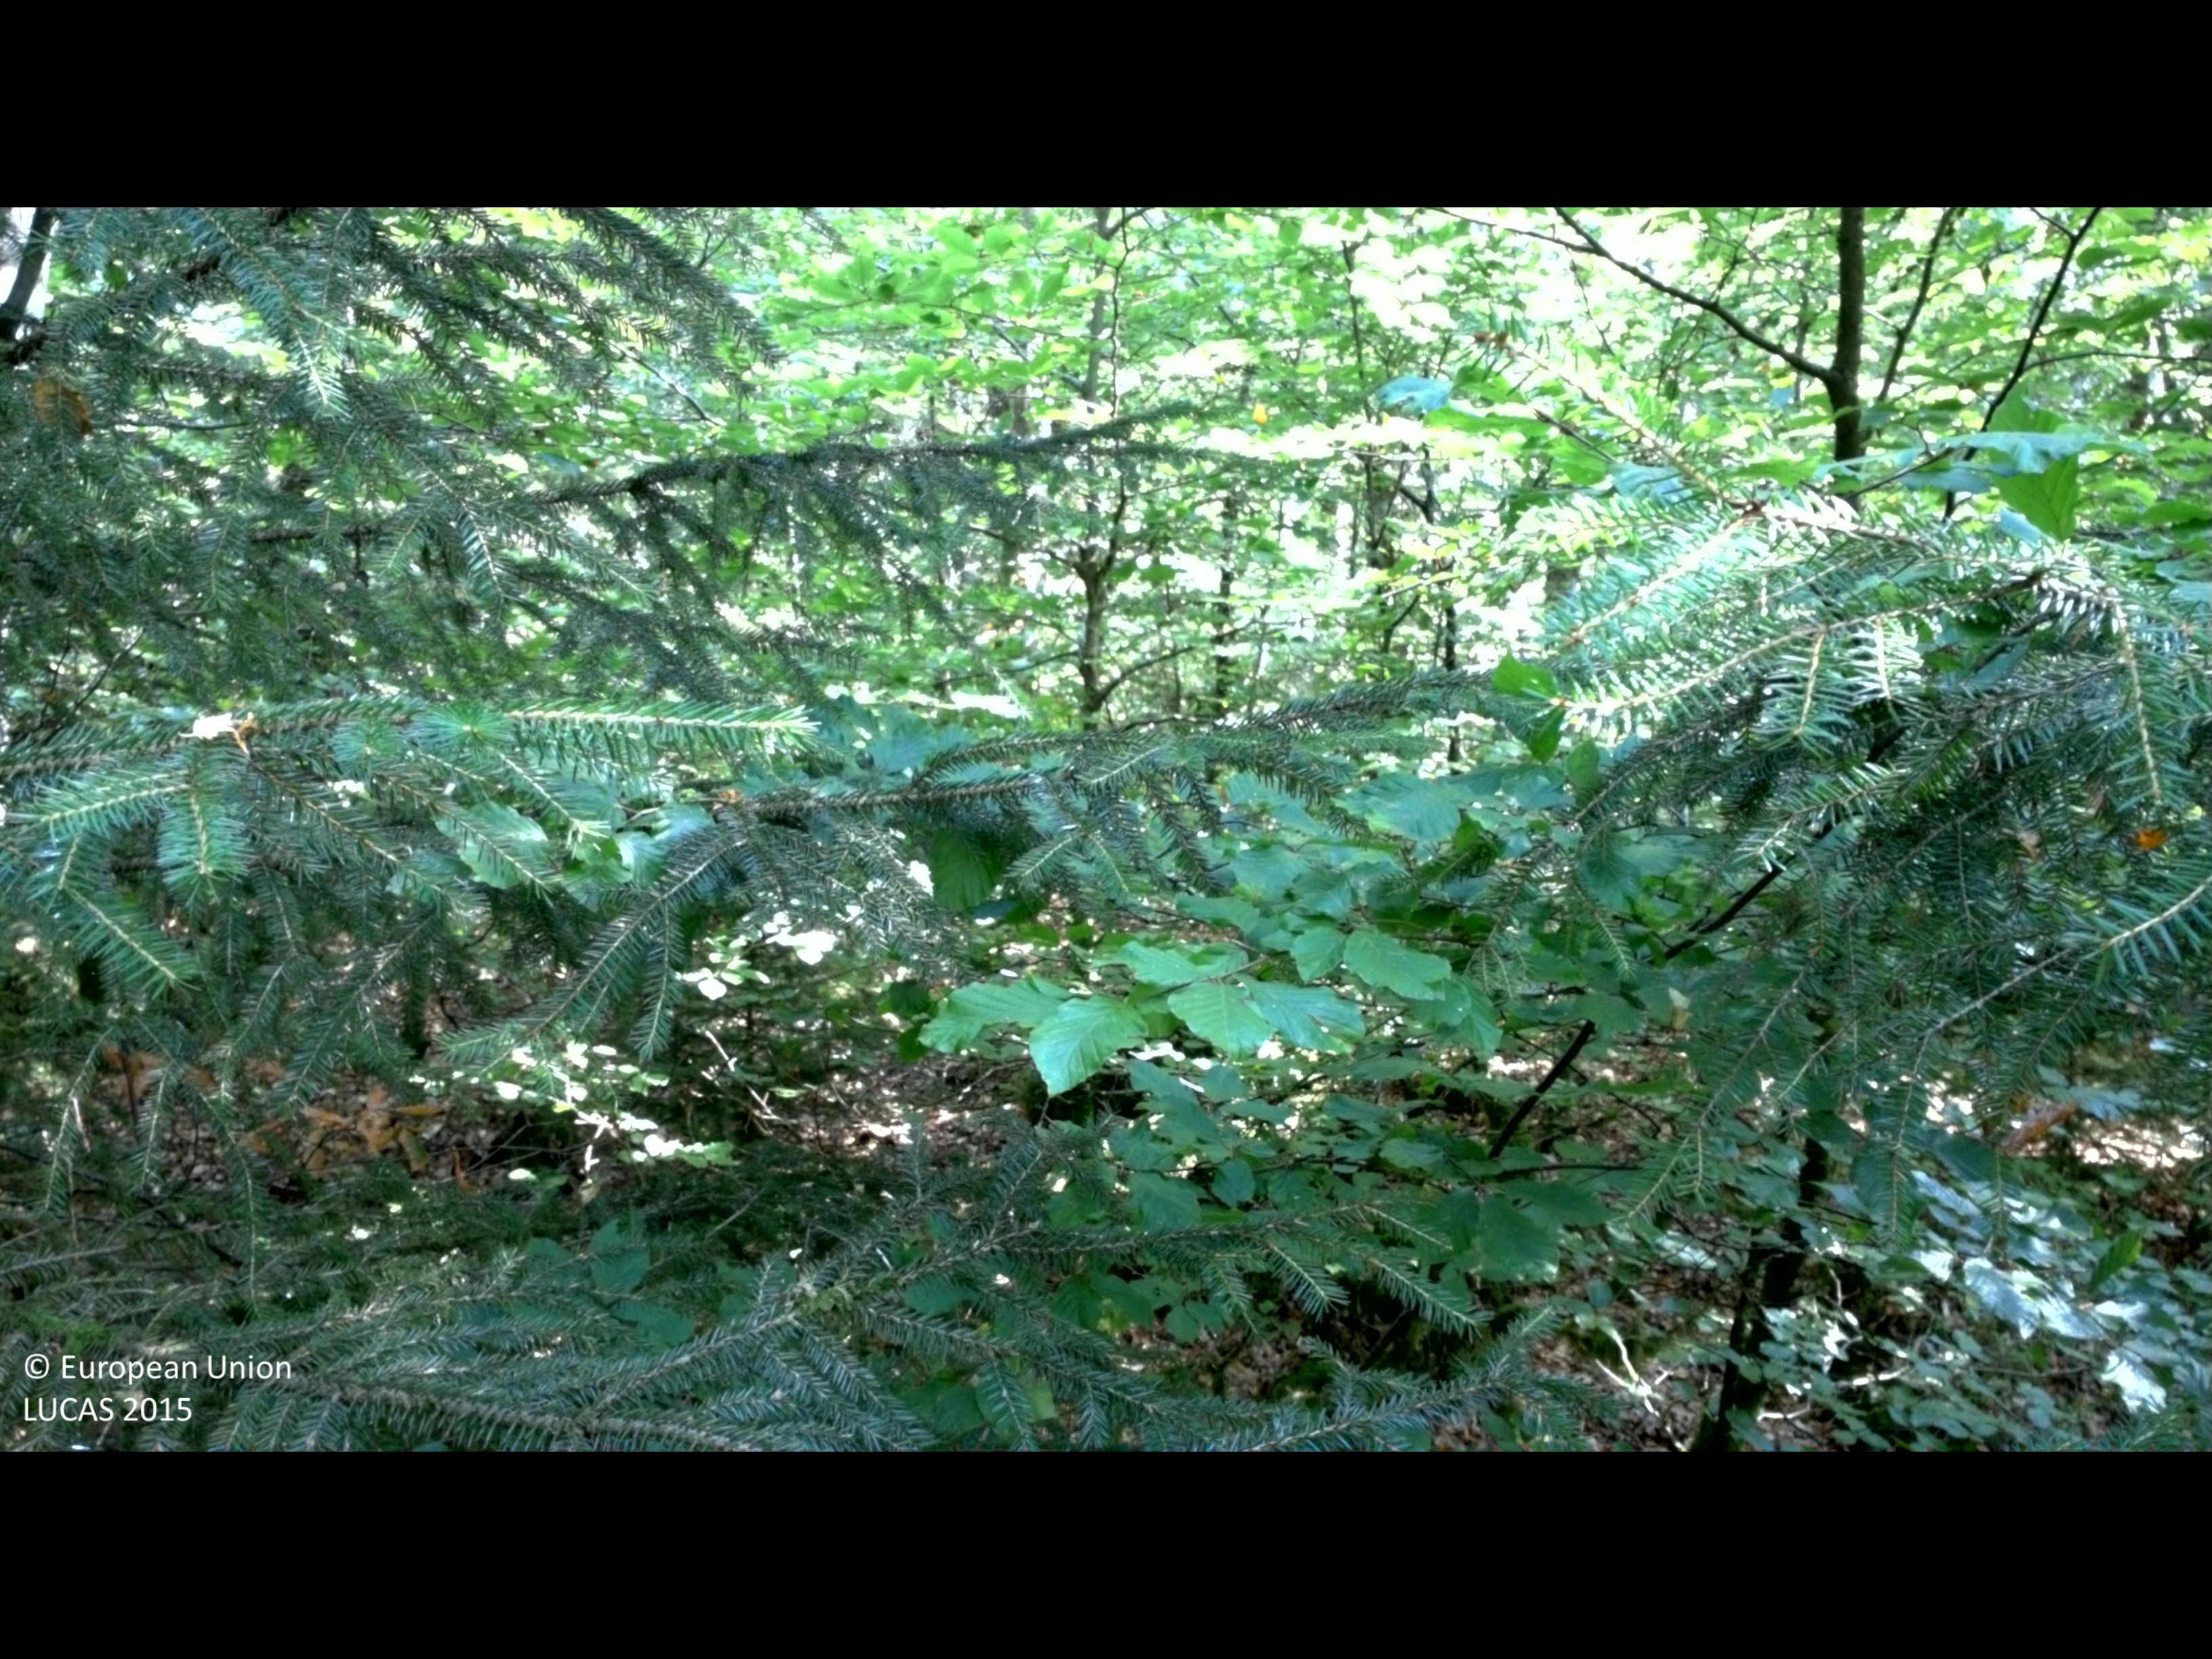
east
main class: Woodland
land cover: Broadleaved woodland
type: hemiboreal forest and nemoral coniferous forest and mixed broadleaved-coniferous forest
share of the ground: > 75 %
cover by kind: broadleaved forest trees 85 %, shrubs 10 %, coniferous forest trees 5 %
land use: Forestry
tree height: > 5 m
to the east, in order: Broadleaved woodland; Spruce dominated coniferous woodland; Broadleaved woodland; Inland fresh water bodies
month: August
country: SE
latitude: 56.8849
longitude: 13.2297
